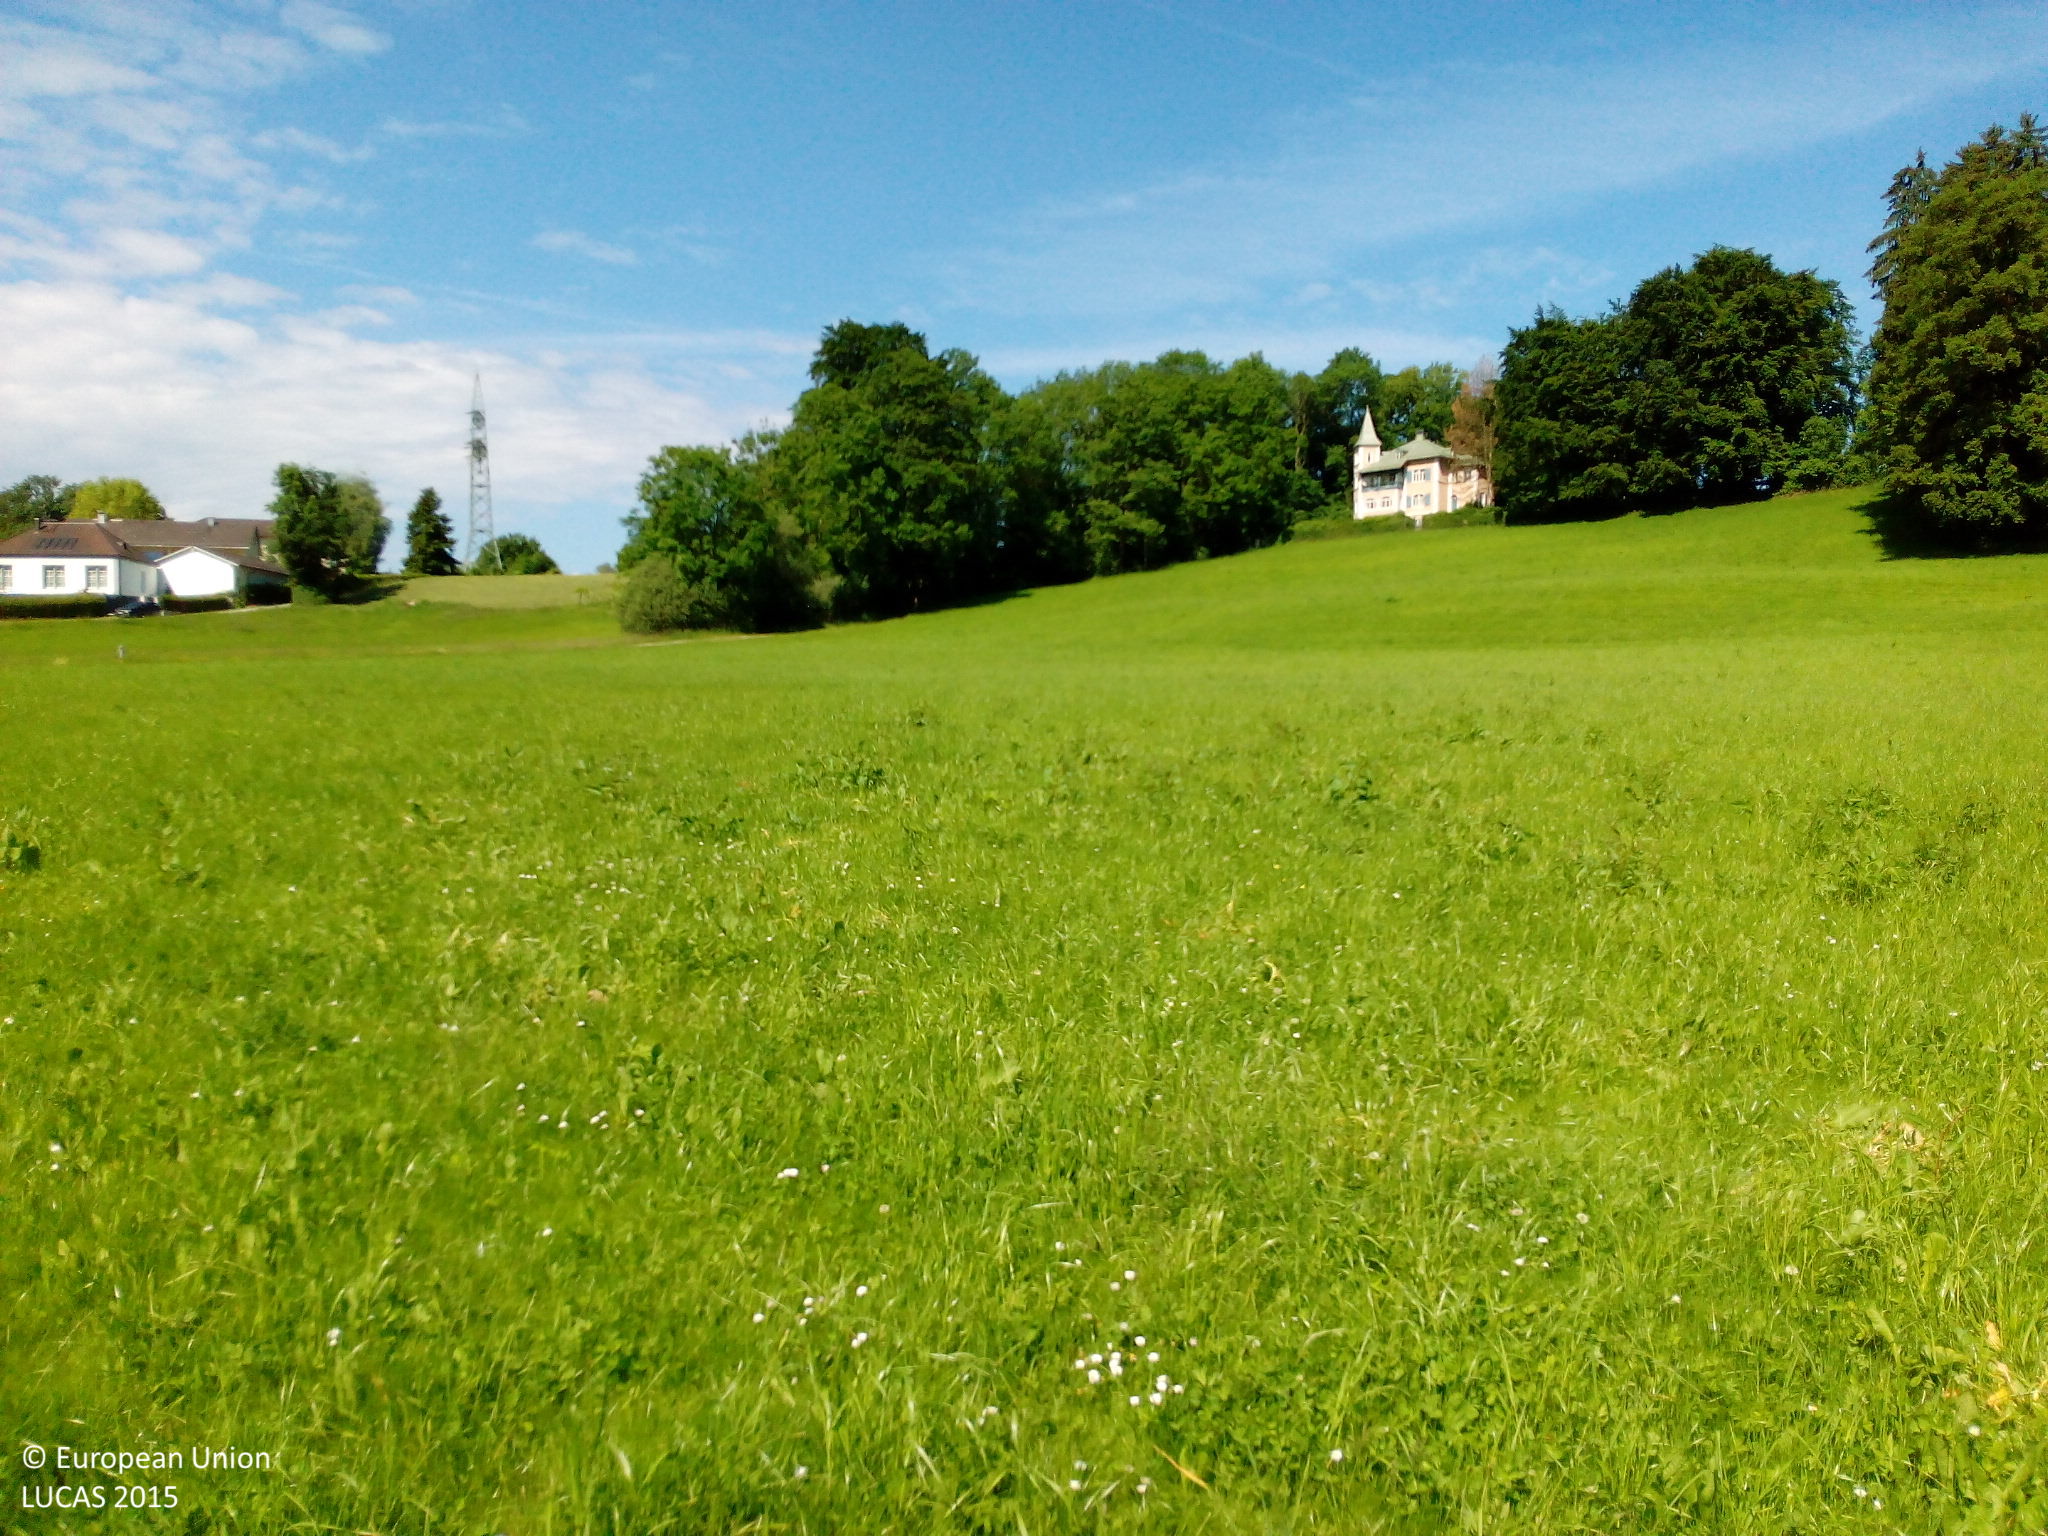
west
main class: Grassland
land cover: Grassland without tree/shrub cover
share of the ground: > 75 %
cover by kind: herbaceous plants 100 %
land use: Agriculture (excluding fallow land and kitchen gardens)
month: June
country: DE
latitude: 47.8567
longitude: 12.3377
